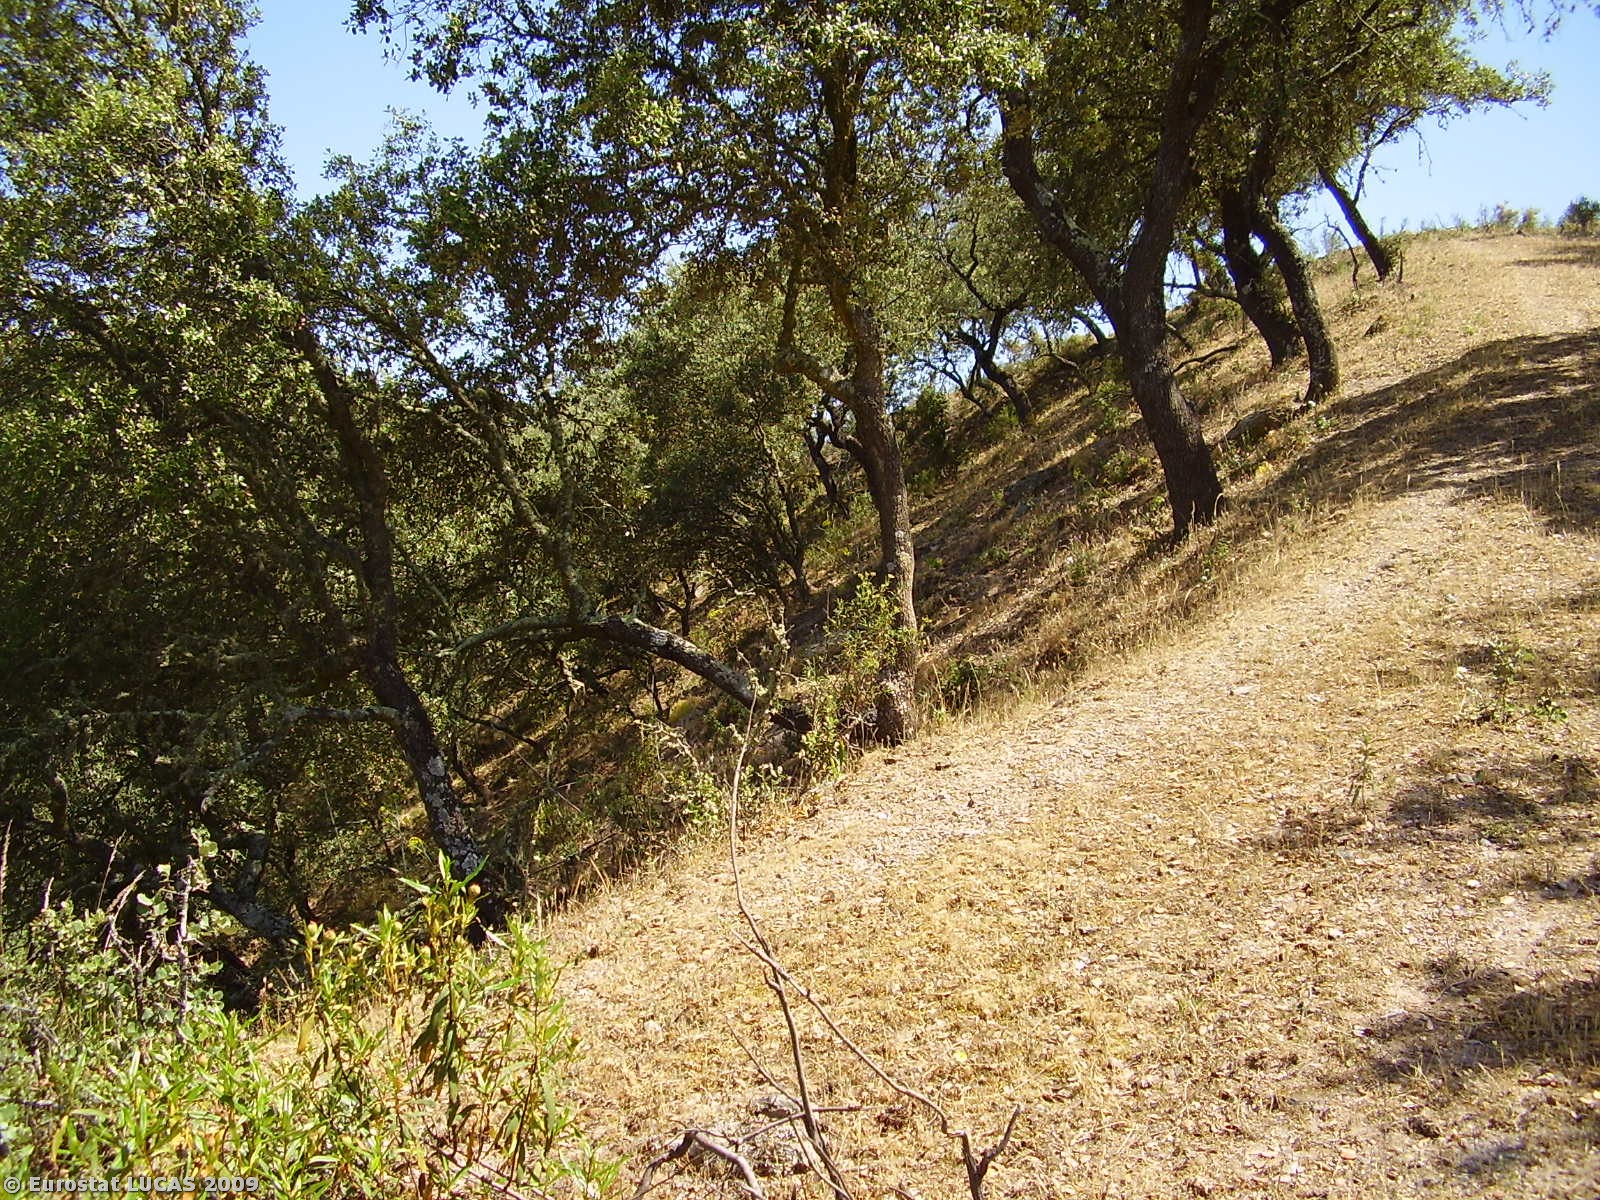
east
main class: Woodland
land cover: Broadleaved woodland
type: broadleaved evergreen forest
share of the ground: 50 - 75 %
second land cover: Bare land
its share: 25 - 50 %
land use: Forestry
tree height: > 5 m
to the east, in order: Broadleaved woodland; Bare land; Fences; Rivers and streams; Fences; Grassland without tree/shrub cover; Broadleaved woodland; Tracks; Broadleaved woodland
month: May
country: PT
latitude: 37.8686
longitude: -7.7908
